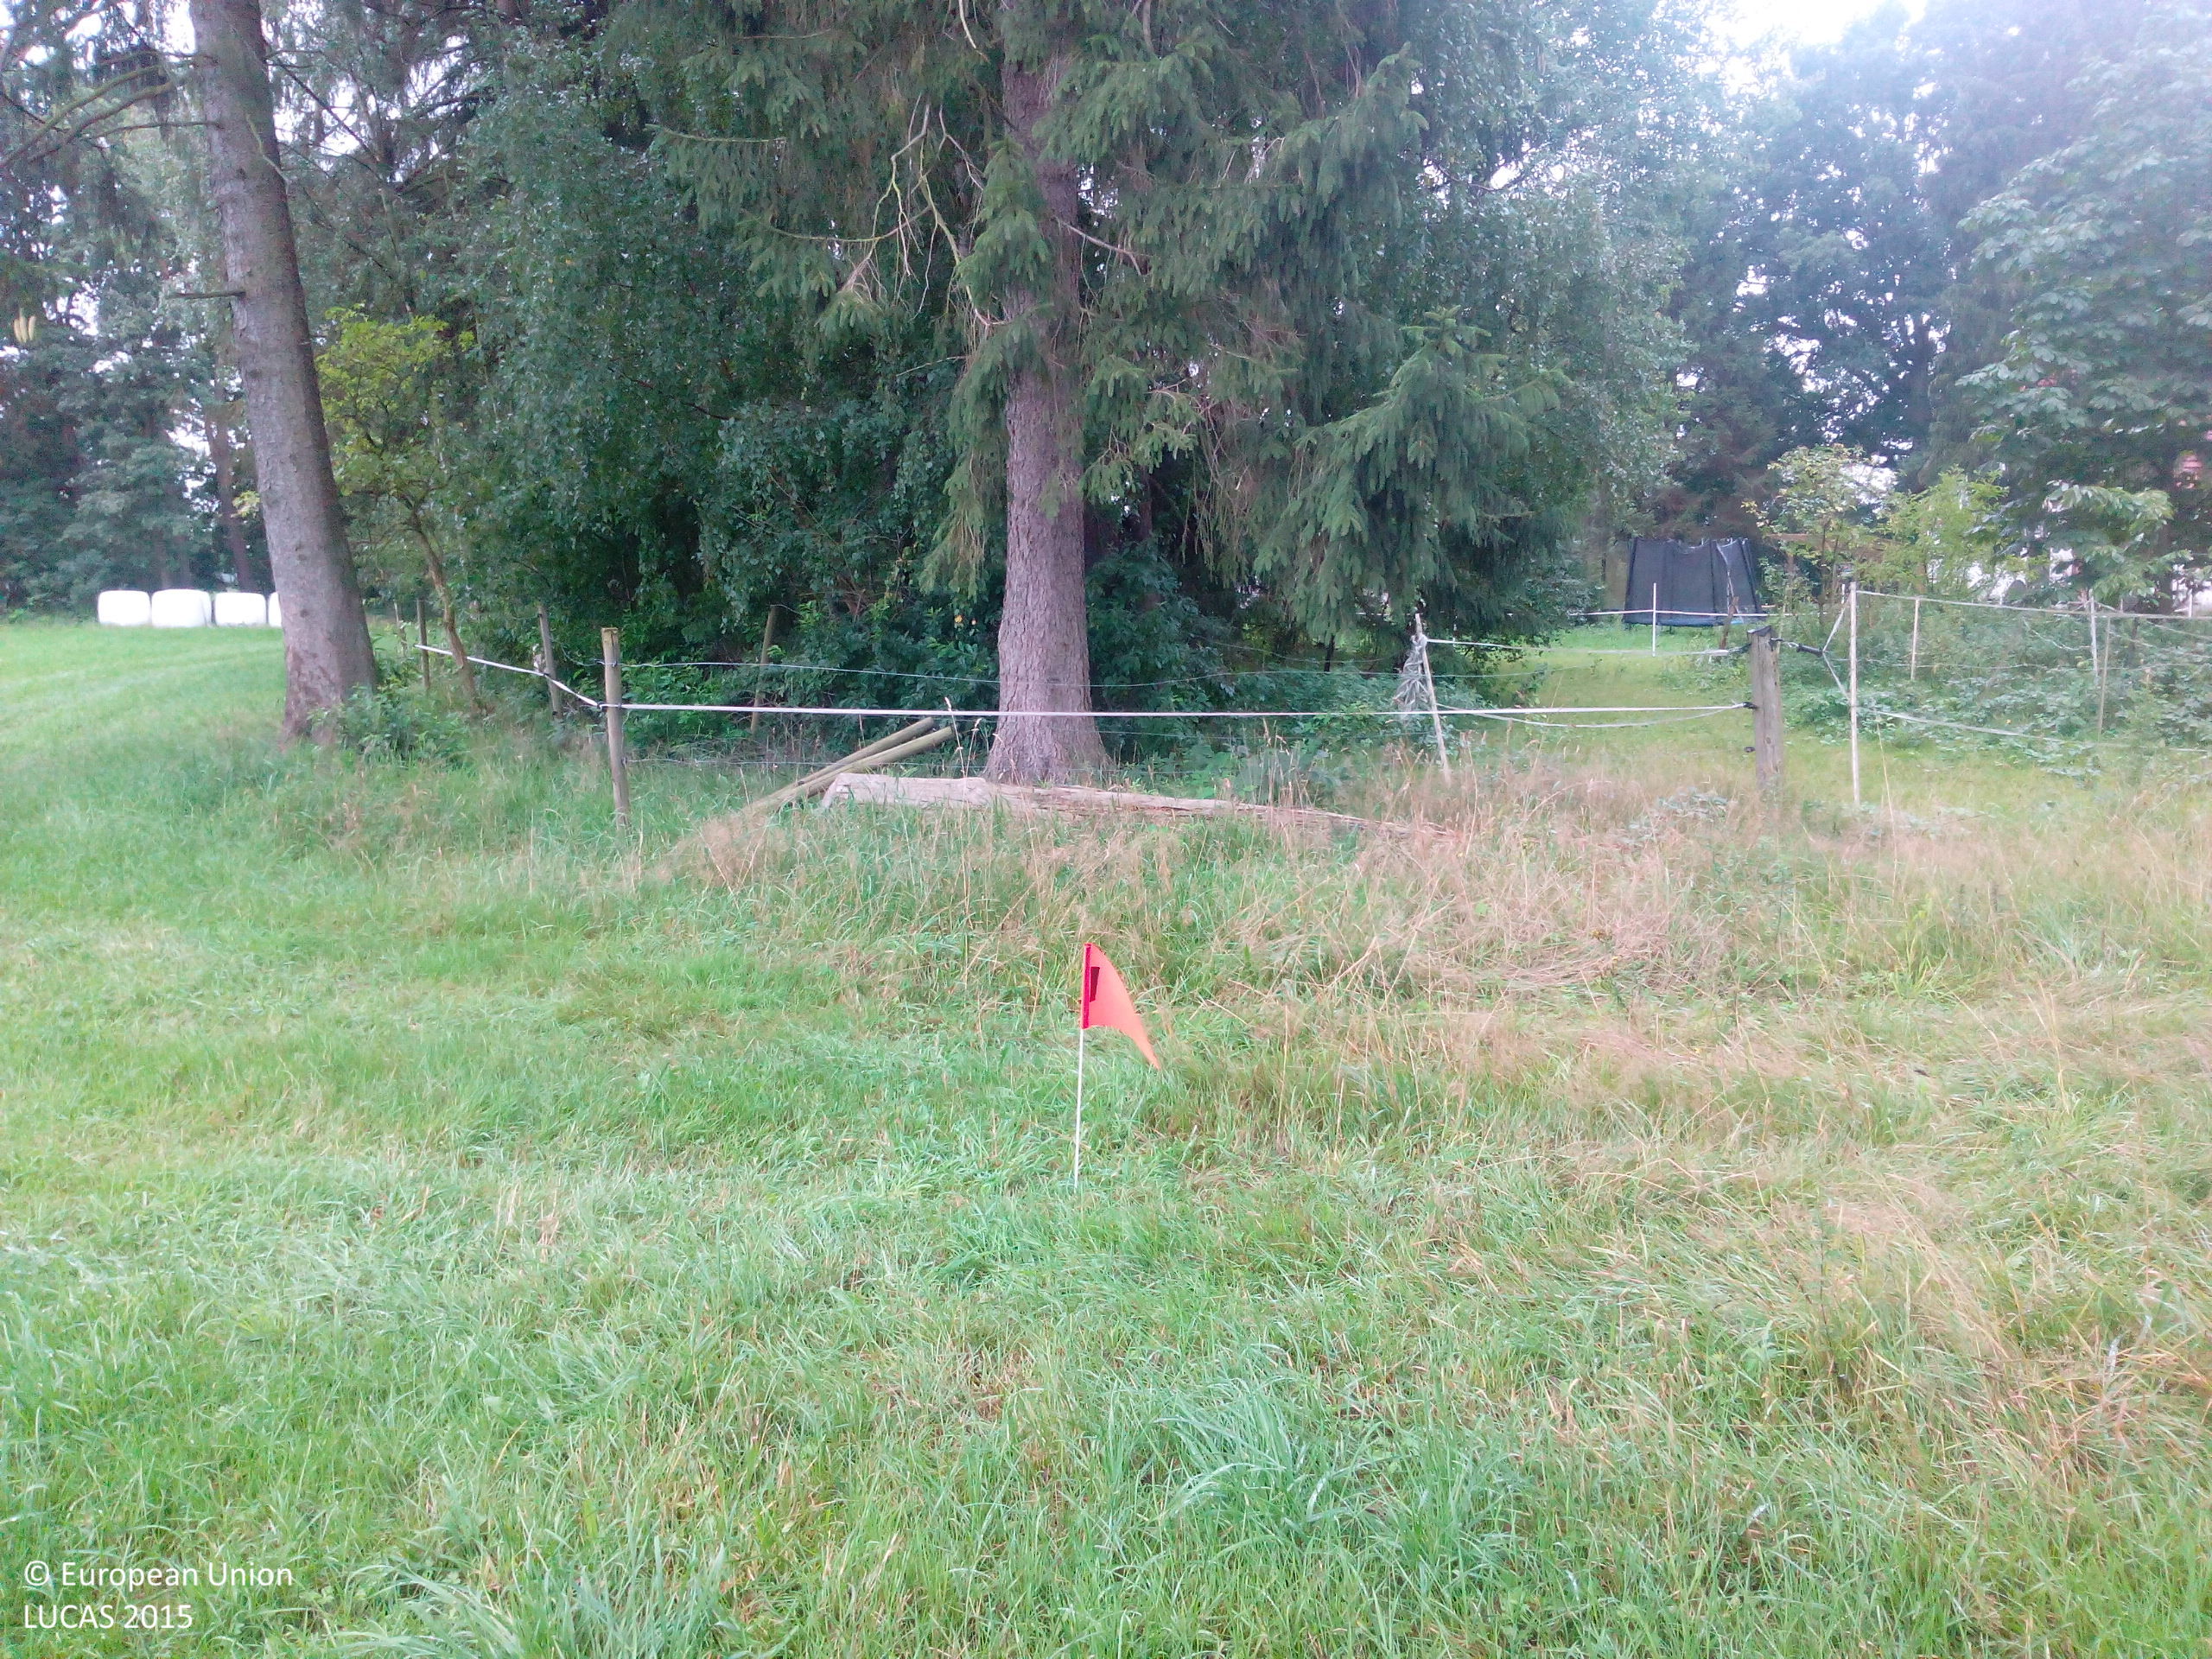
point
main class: Grassland
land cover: Grassland without tree/shrub cover
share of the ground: > 75 %
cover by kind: herbaceous plants 100 %
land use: Agriculture (excluding fallow land and kitchen gardens)
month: August
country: DE
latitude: 53.7254
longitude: 9.9546
